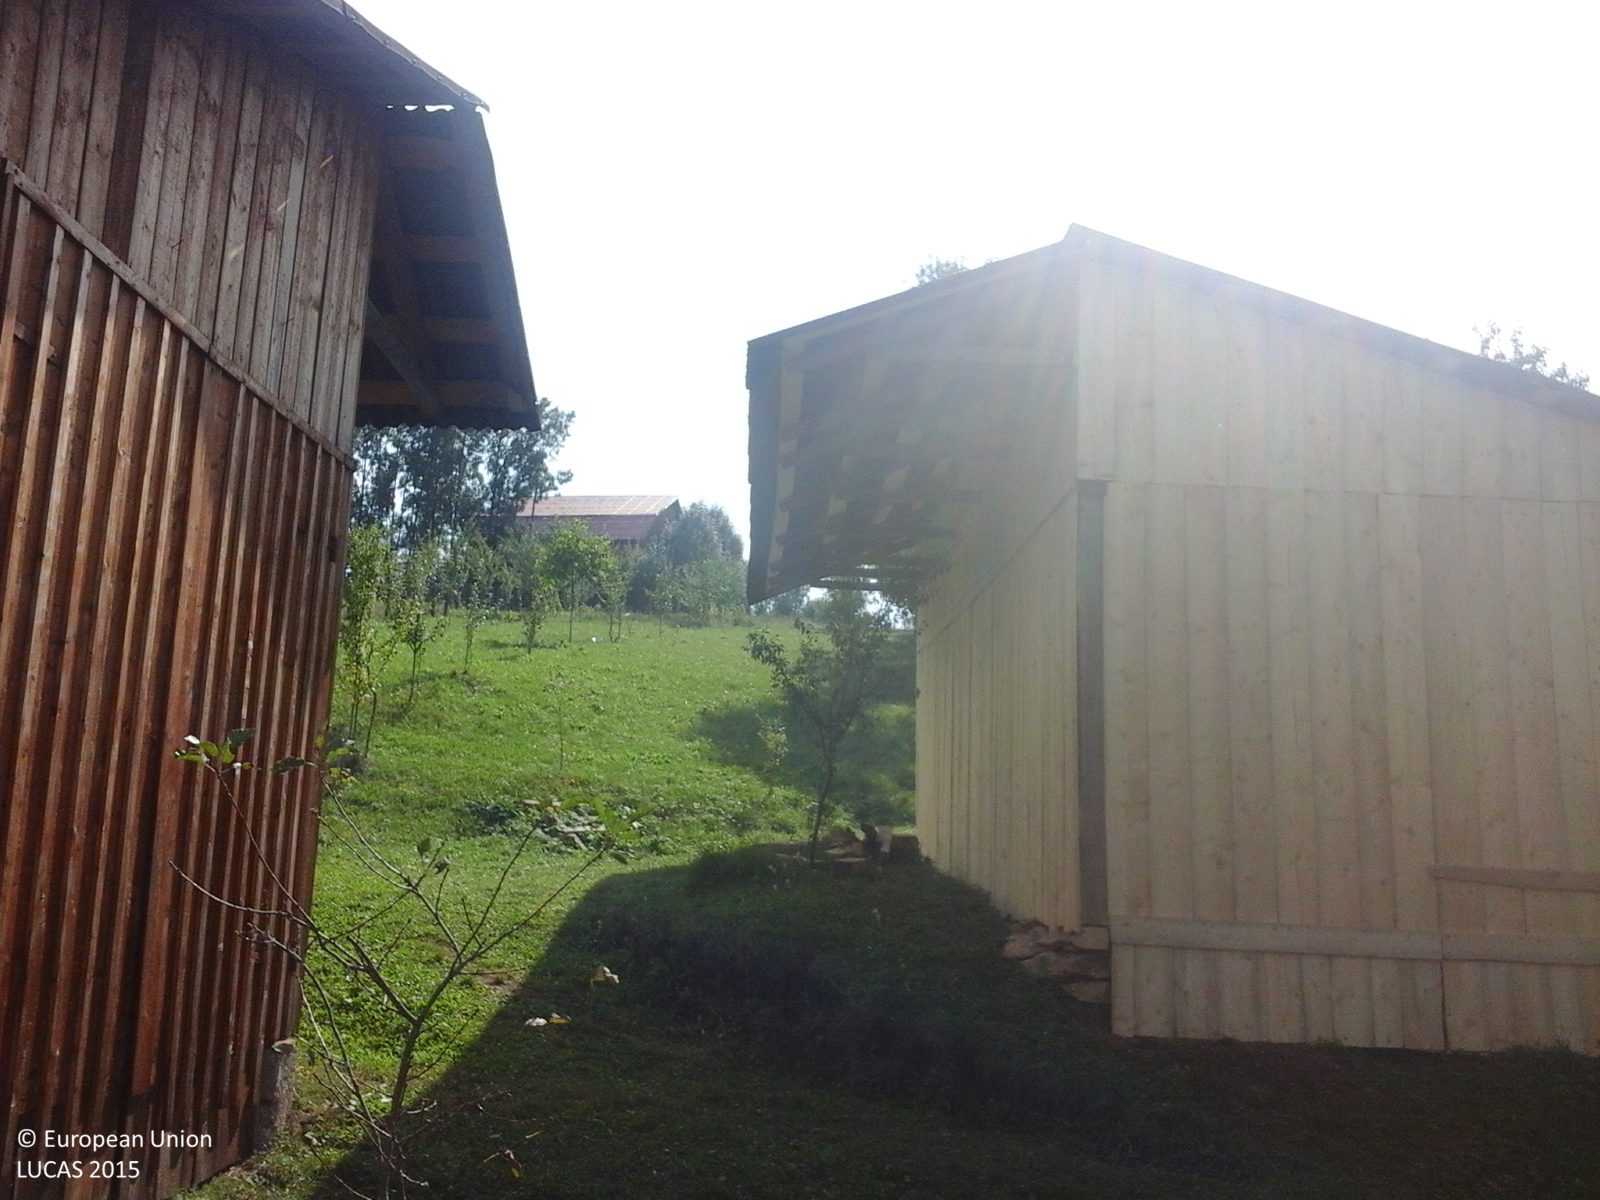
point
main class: Cropland
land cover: Apple fruit
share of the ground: > 75 %
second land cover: Grassland without tree/shrub cover
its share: > 75 %
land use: Agriculture (excluding fallow land and kitchen gardens)
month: September
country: RO
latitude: 46.8079
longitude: 23.1815
